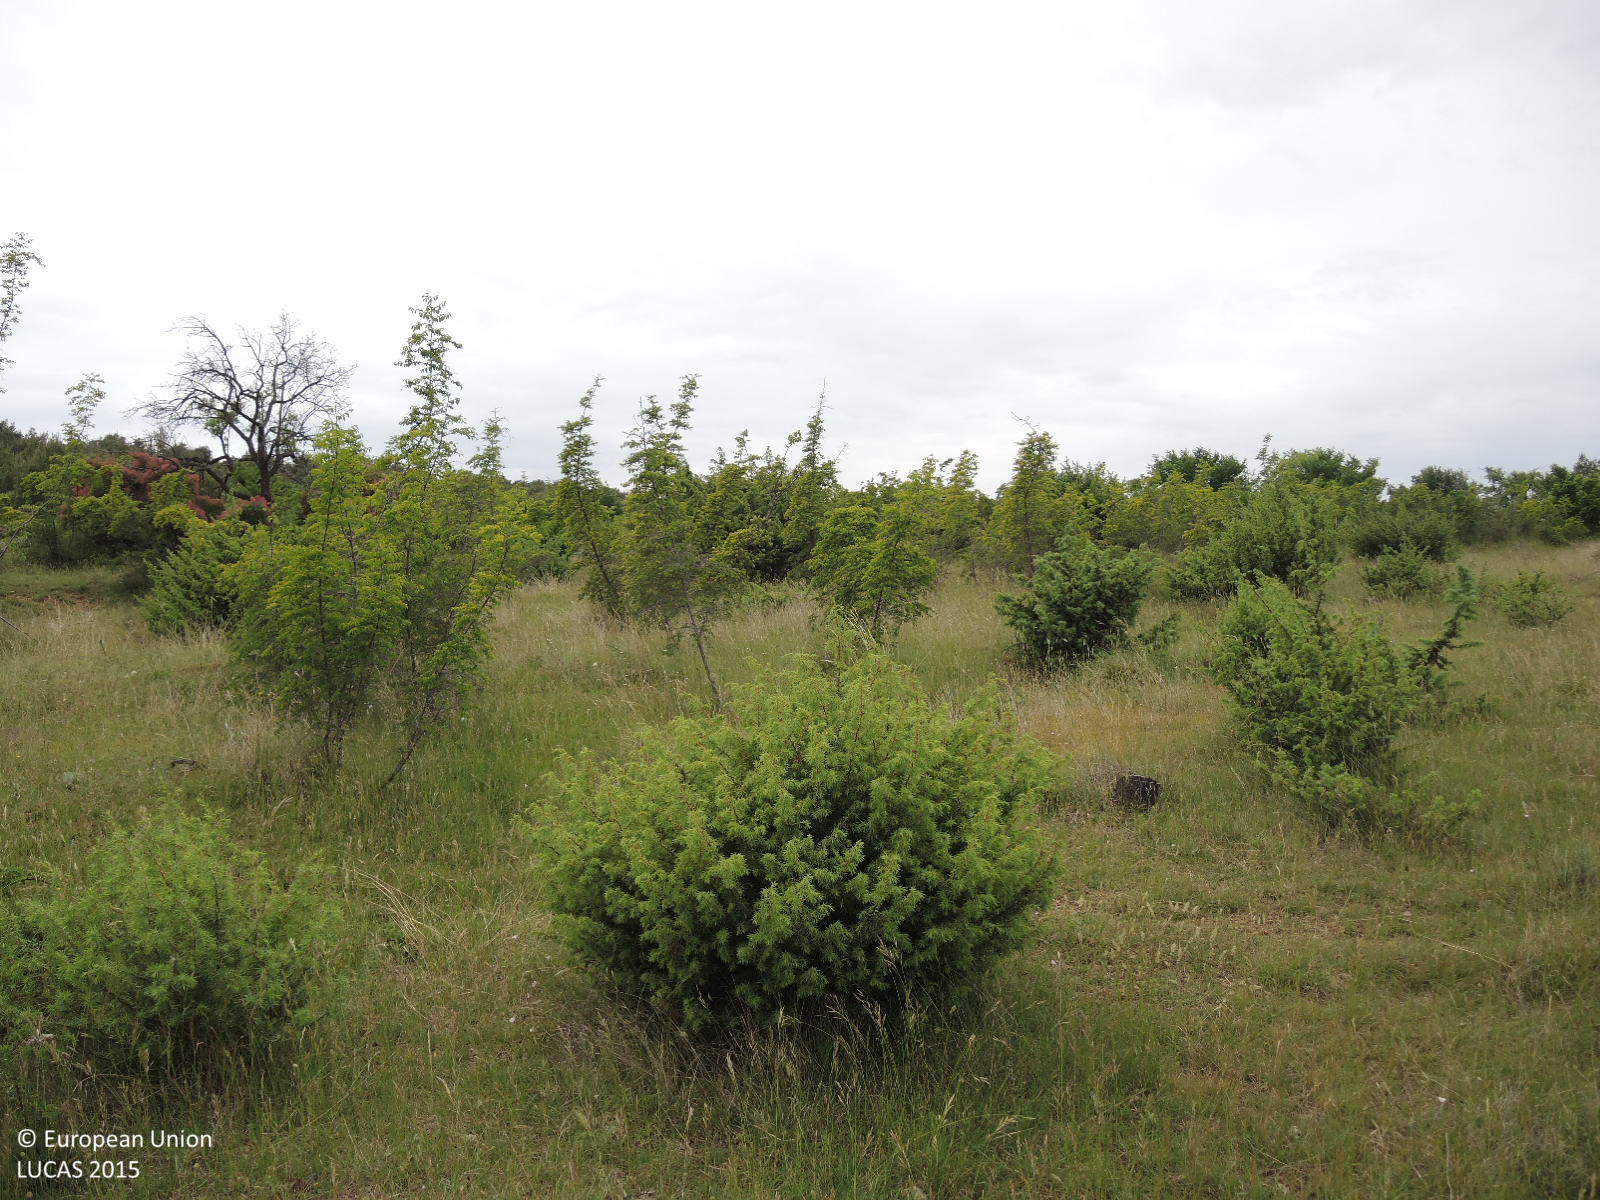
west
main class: Shrubland
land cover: Shrubland without tree cover
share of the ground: 10 - 25 %
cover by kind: herbaceous plants 65 %, shrubs 25 %, unconsolidated bare surface 10 %
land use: Semi-natural and natural areas not in use
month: May
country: HR
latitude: 43.9153
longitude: 15.8322
